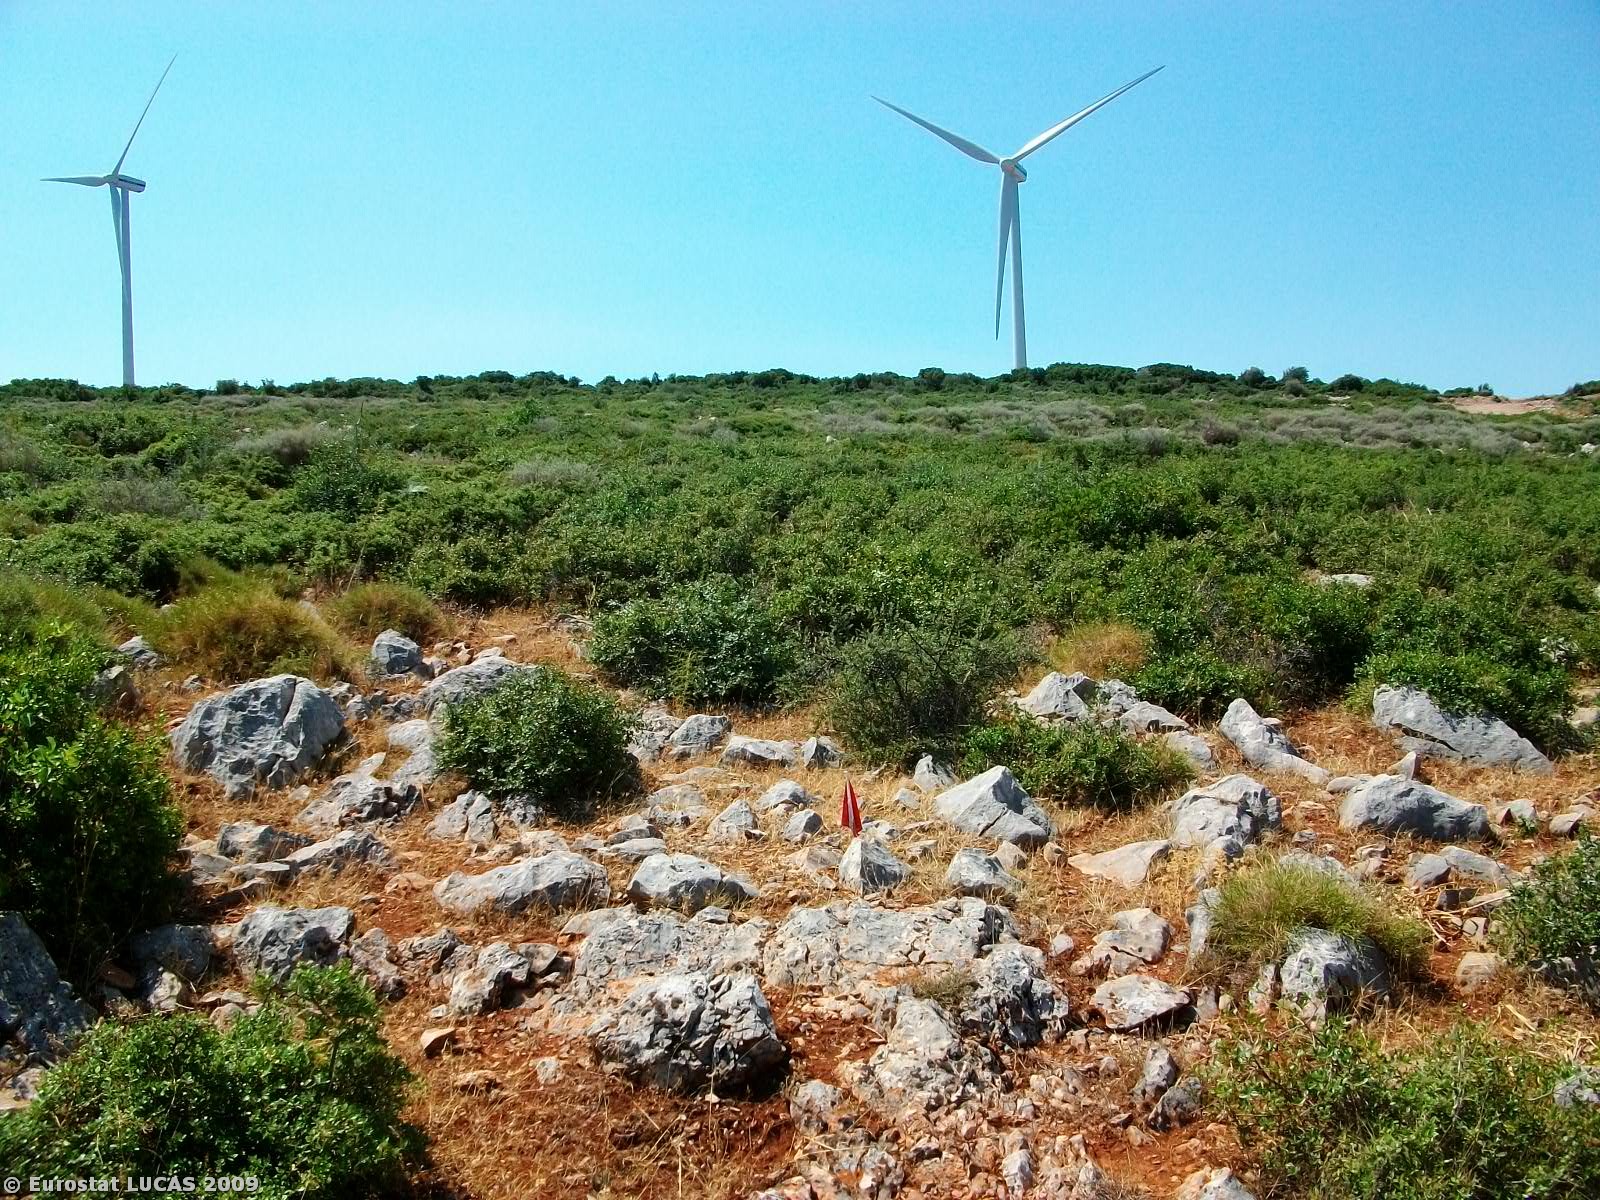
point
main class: Shrubland
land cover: Shrubland without tree cover
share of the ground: > 75 %
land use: Agriculture (excluding fallow land and kitchen gardens)
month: July
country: GR
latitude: 38.5398
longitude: 23.1184
